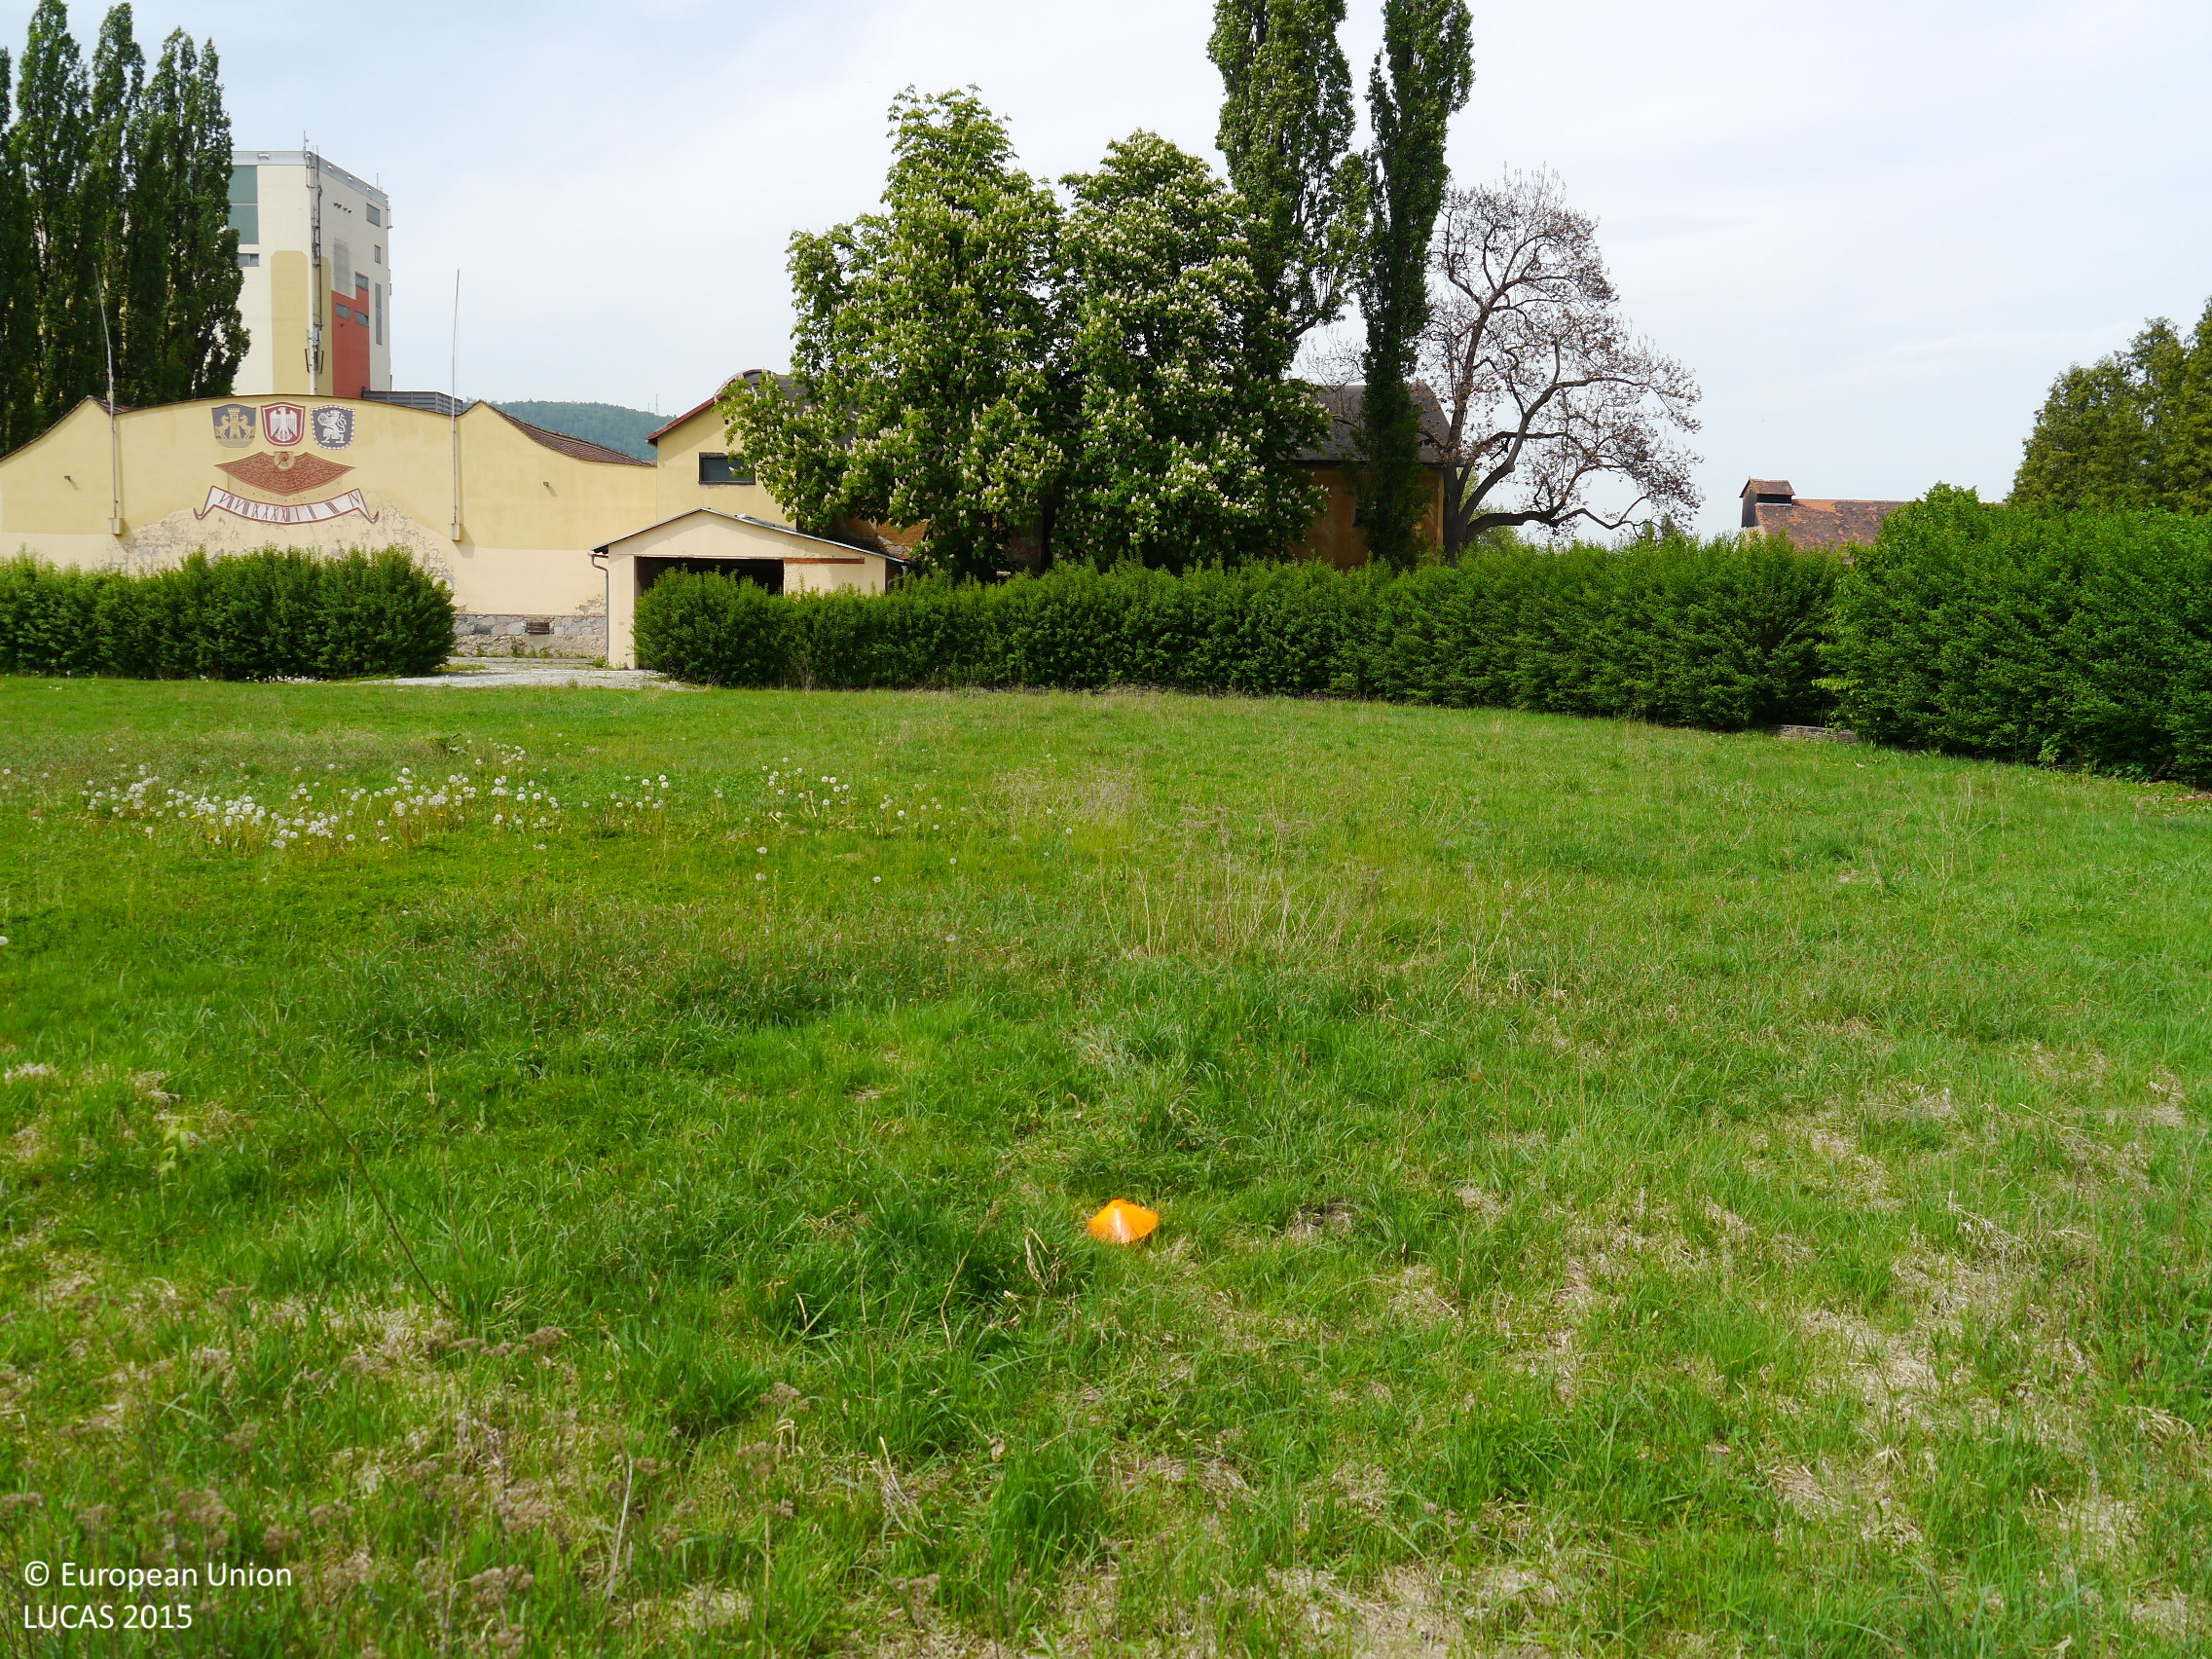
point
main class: Grassland
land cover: Grassland without tree/shrub cover
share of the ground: > 75 %
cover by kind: herbaceous plants 100 %
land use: Sport
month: May
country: AT
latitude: 47.0625
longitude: 15.4112
